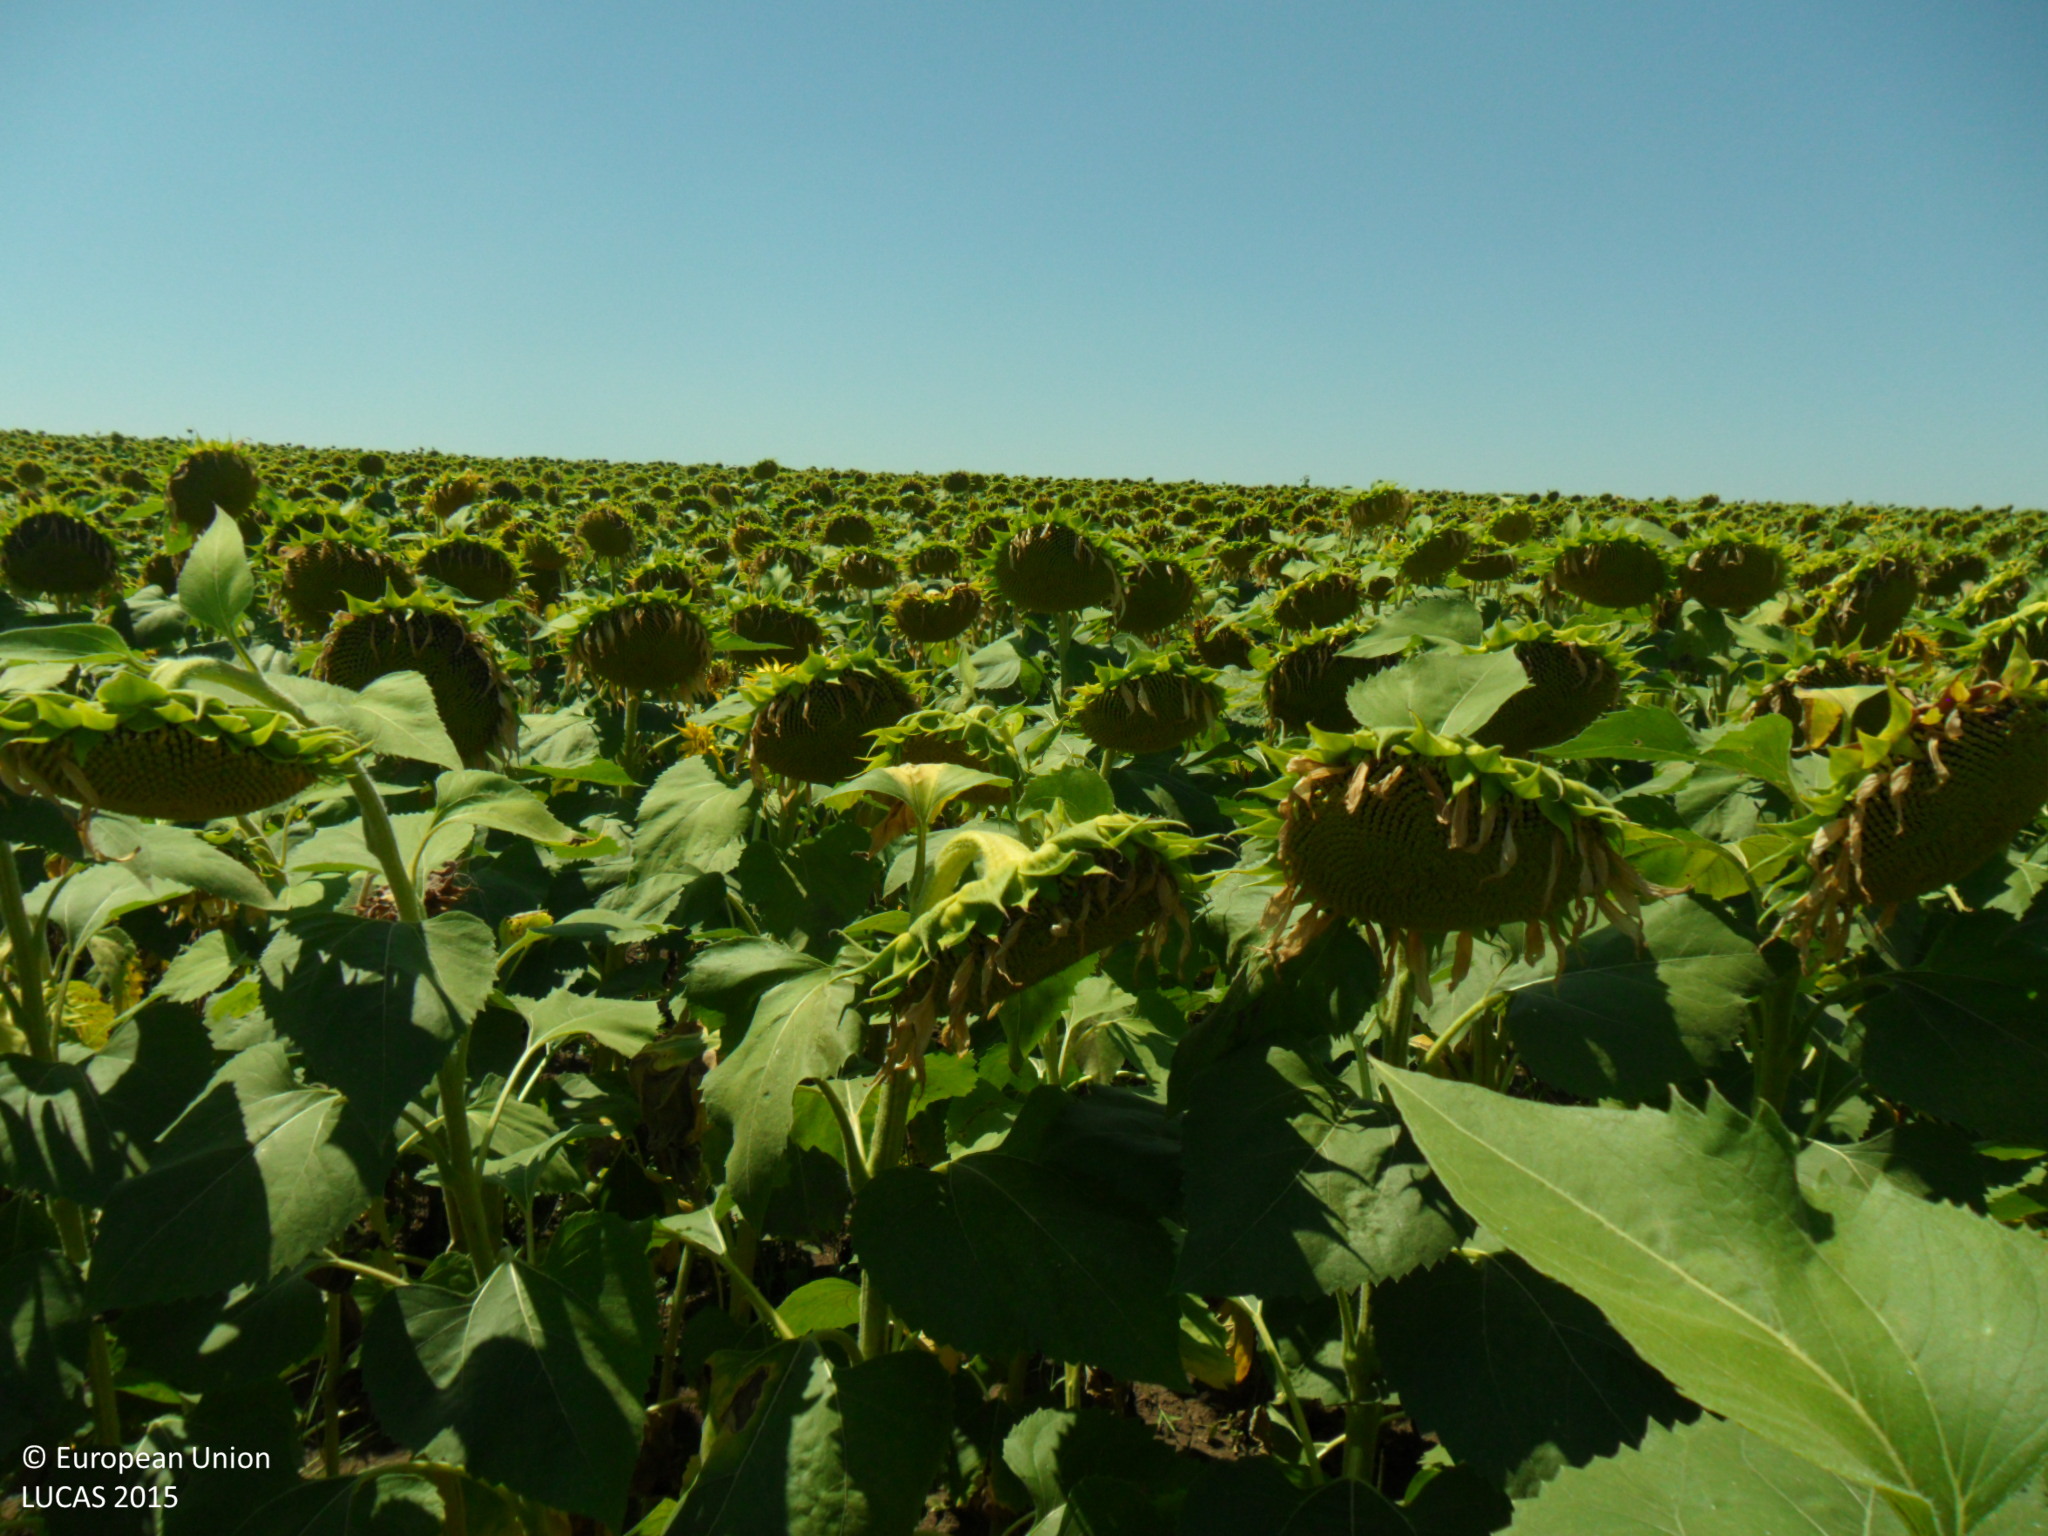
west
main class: Cropland
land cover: Sunflower
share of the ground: > 75 %
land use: Agriculture (excluding fallow land and kitchen gardens)
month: July
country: BG
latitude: 43.8415
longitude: 26.4123
